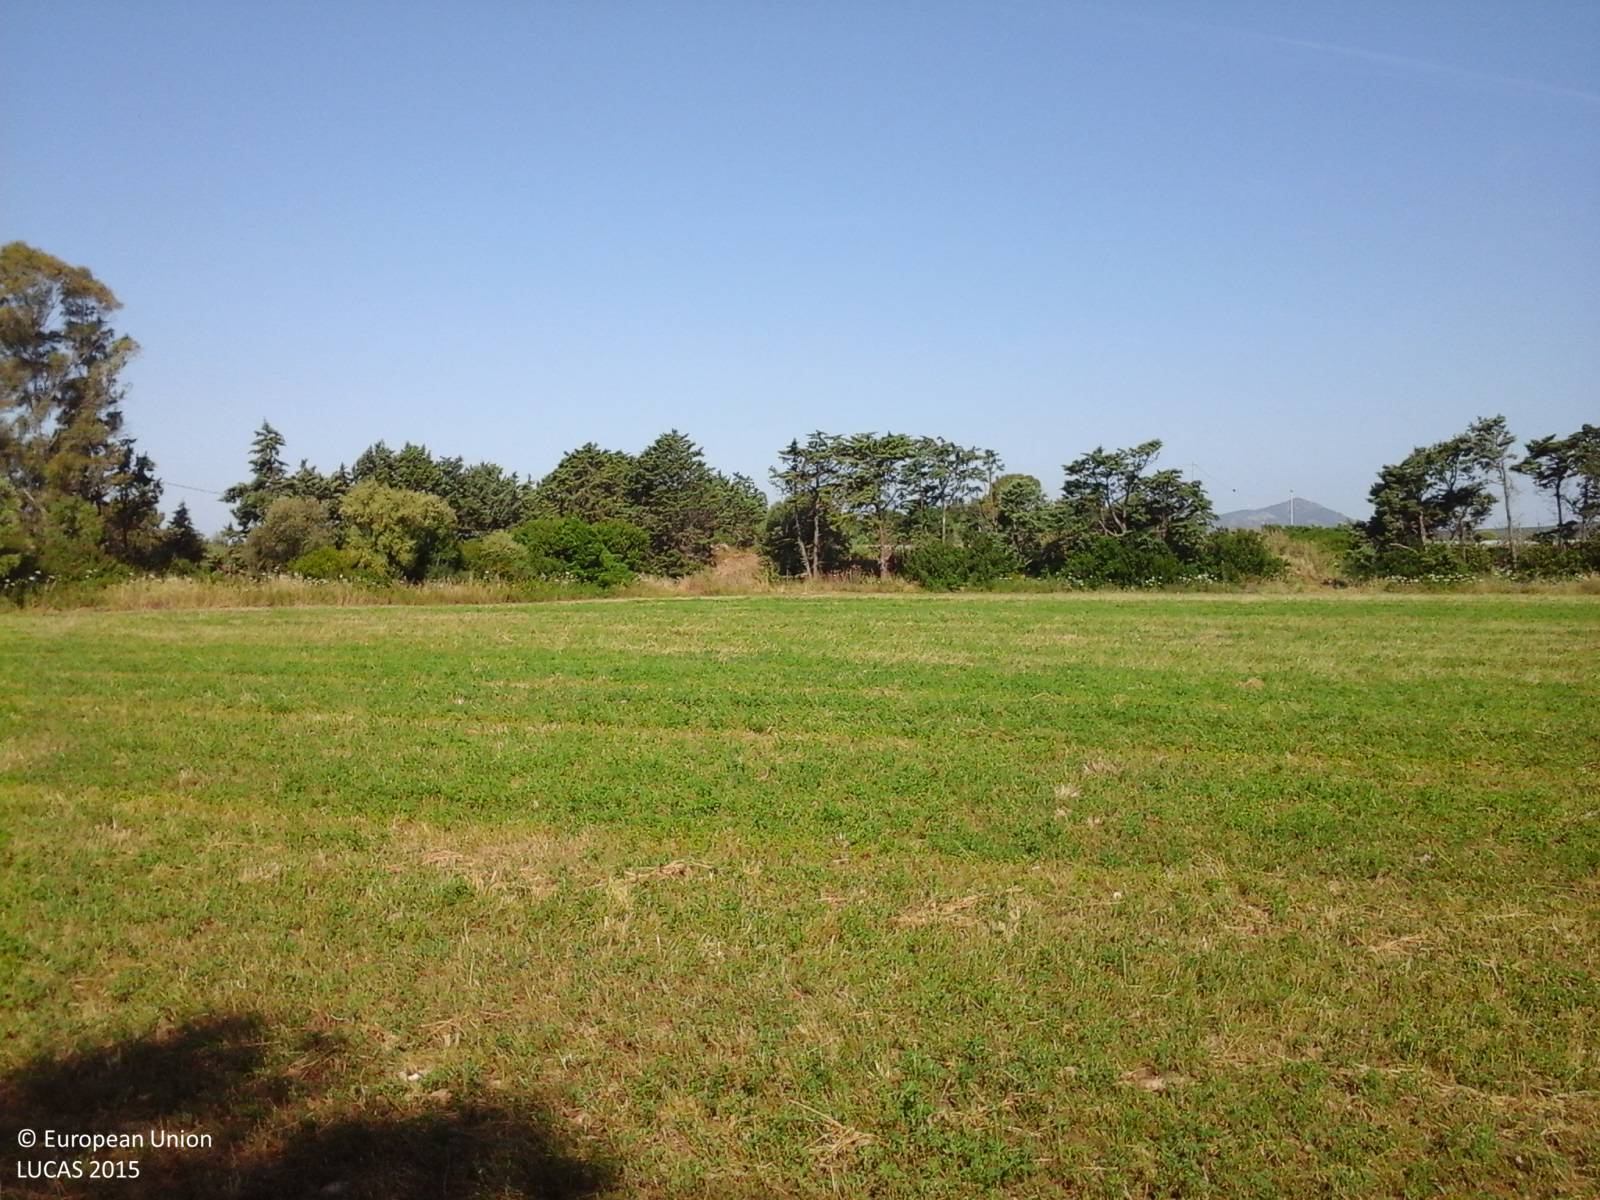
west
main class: Cropland
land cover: Lucerne
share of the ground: 50 - 75 %
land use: Agriculture (excluding fallow land and kitchen gardens)
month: June
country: IT
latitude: 40.6704
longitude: 8.3871
